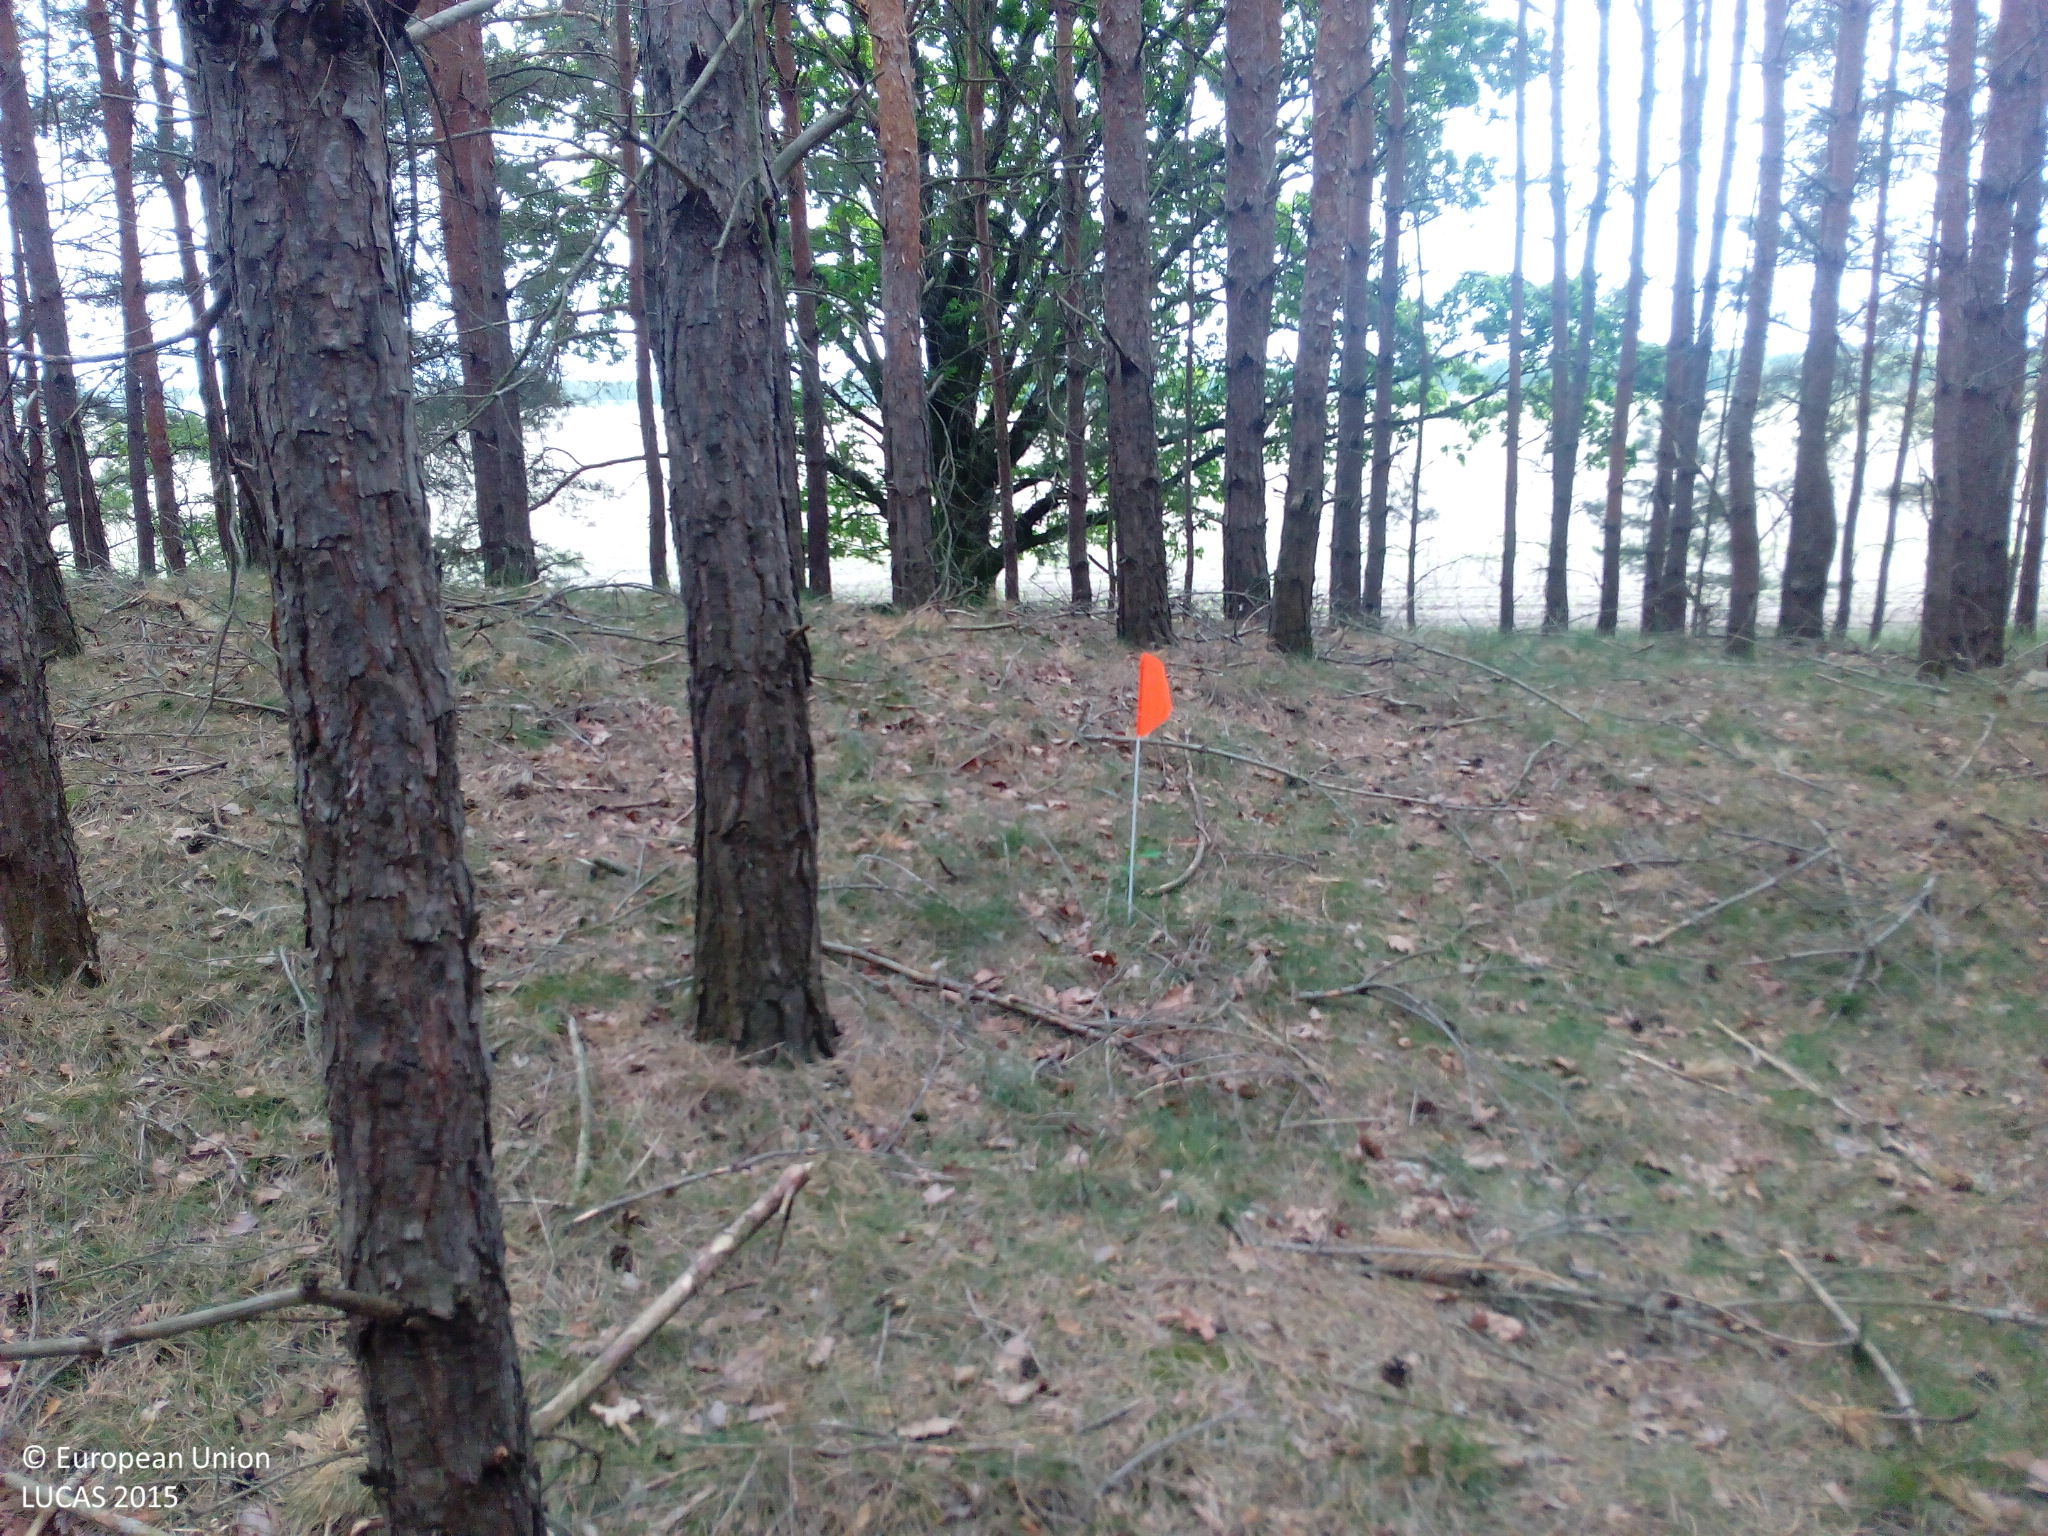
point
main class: Woodland
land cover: Pine dominated coniferous woodland
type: hemiboreal forest and nemoral coniferous forest and mixed broadleaved-coniferous forest
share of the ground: > 75 %
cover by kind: coniferous forest trees 80 %, herbaceous plants 10 %, unconsolidated bare surface 10 %
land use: Forestry
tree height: > 5 m
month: May
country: DE
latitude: 52.1919
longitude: 13.1451
